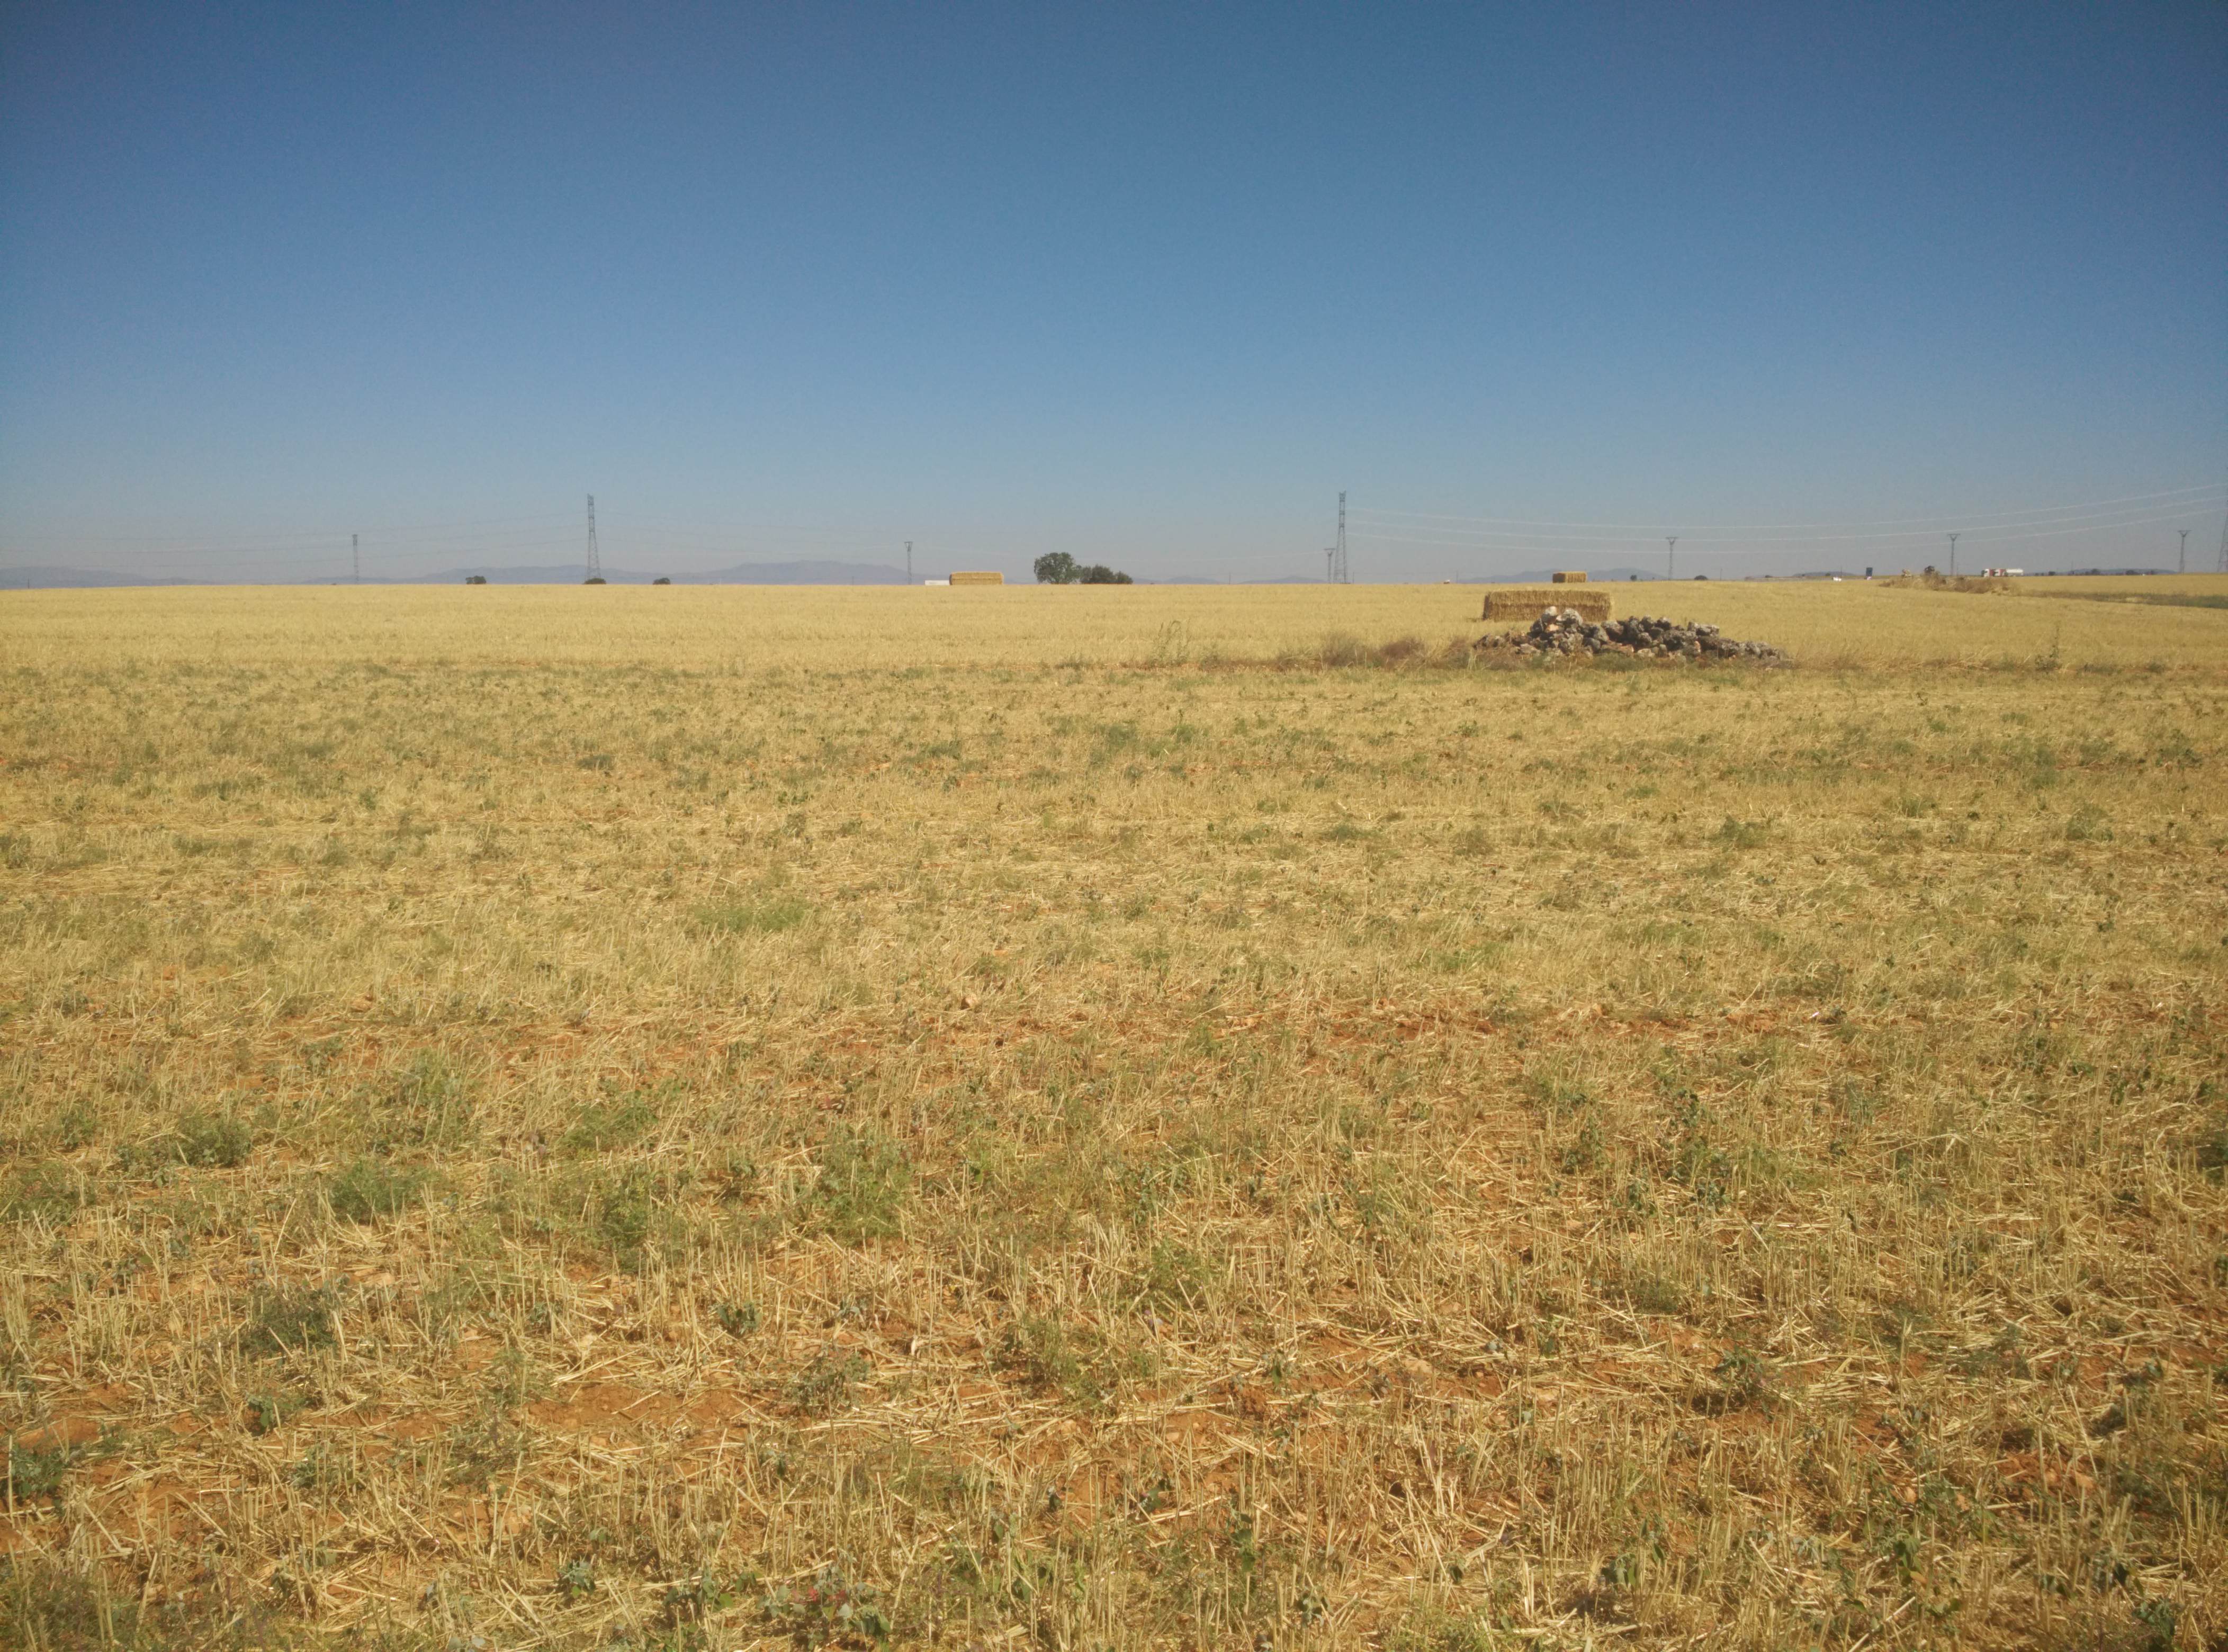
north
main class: Cropland
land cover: Barley
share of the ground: < 10 %
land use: Agriculture (excluding fallow land and kitchen gardens)
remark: Harvested field
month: July
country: ES
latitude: 40.8446
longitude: -2.8536
